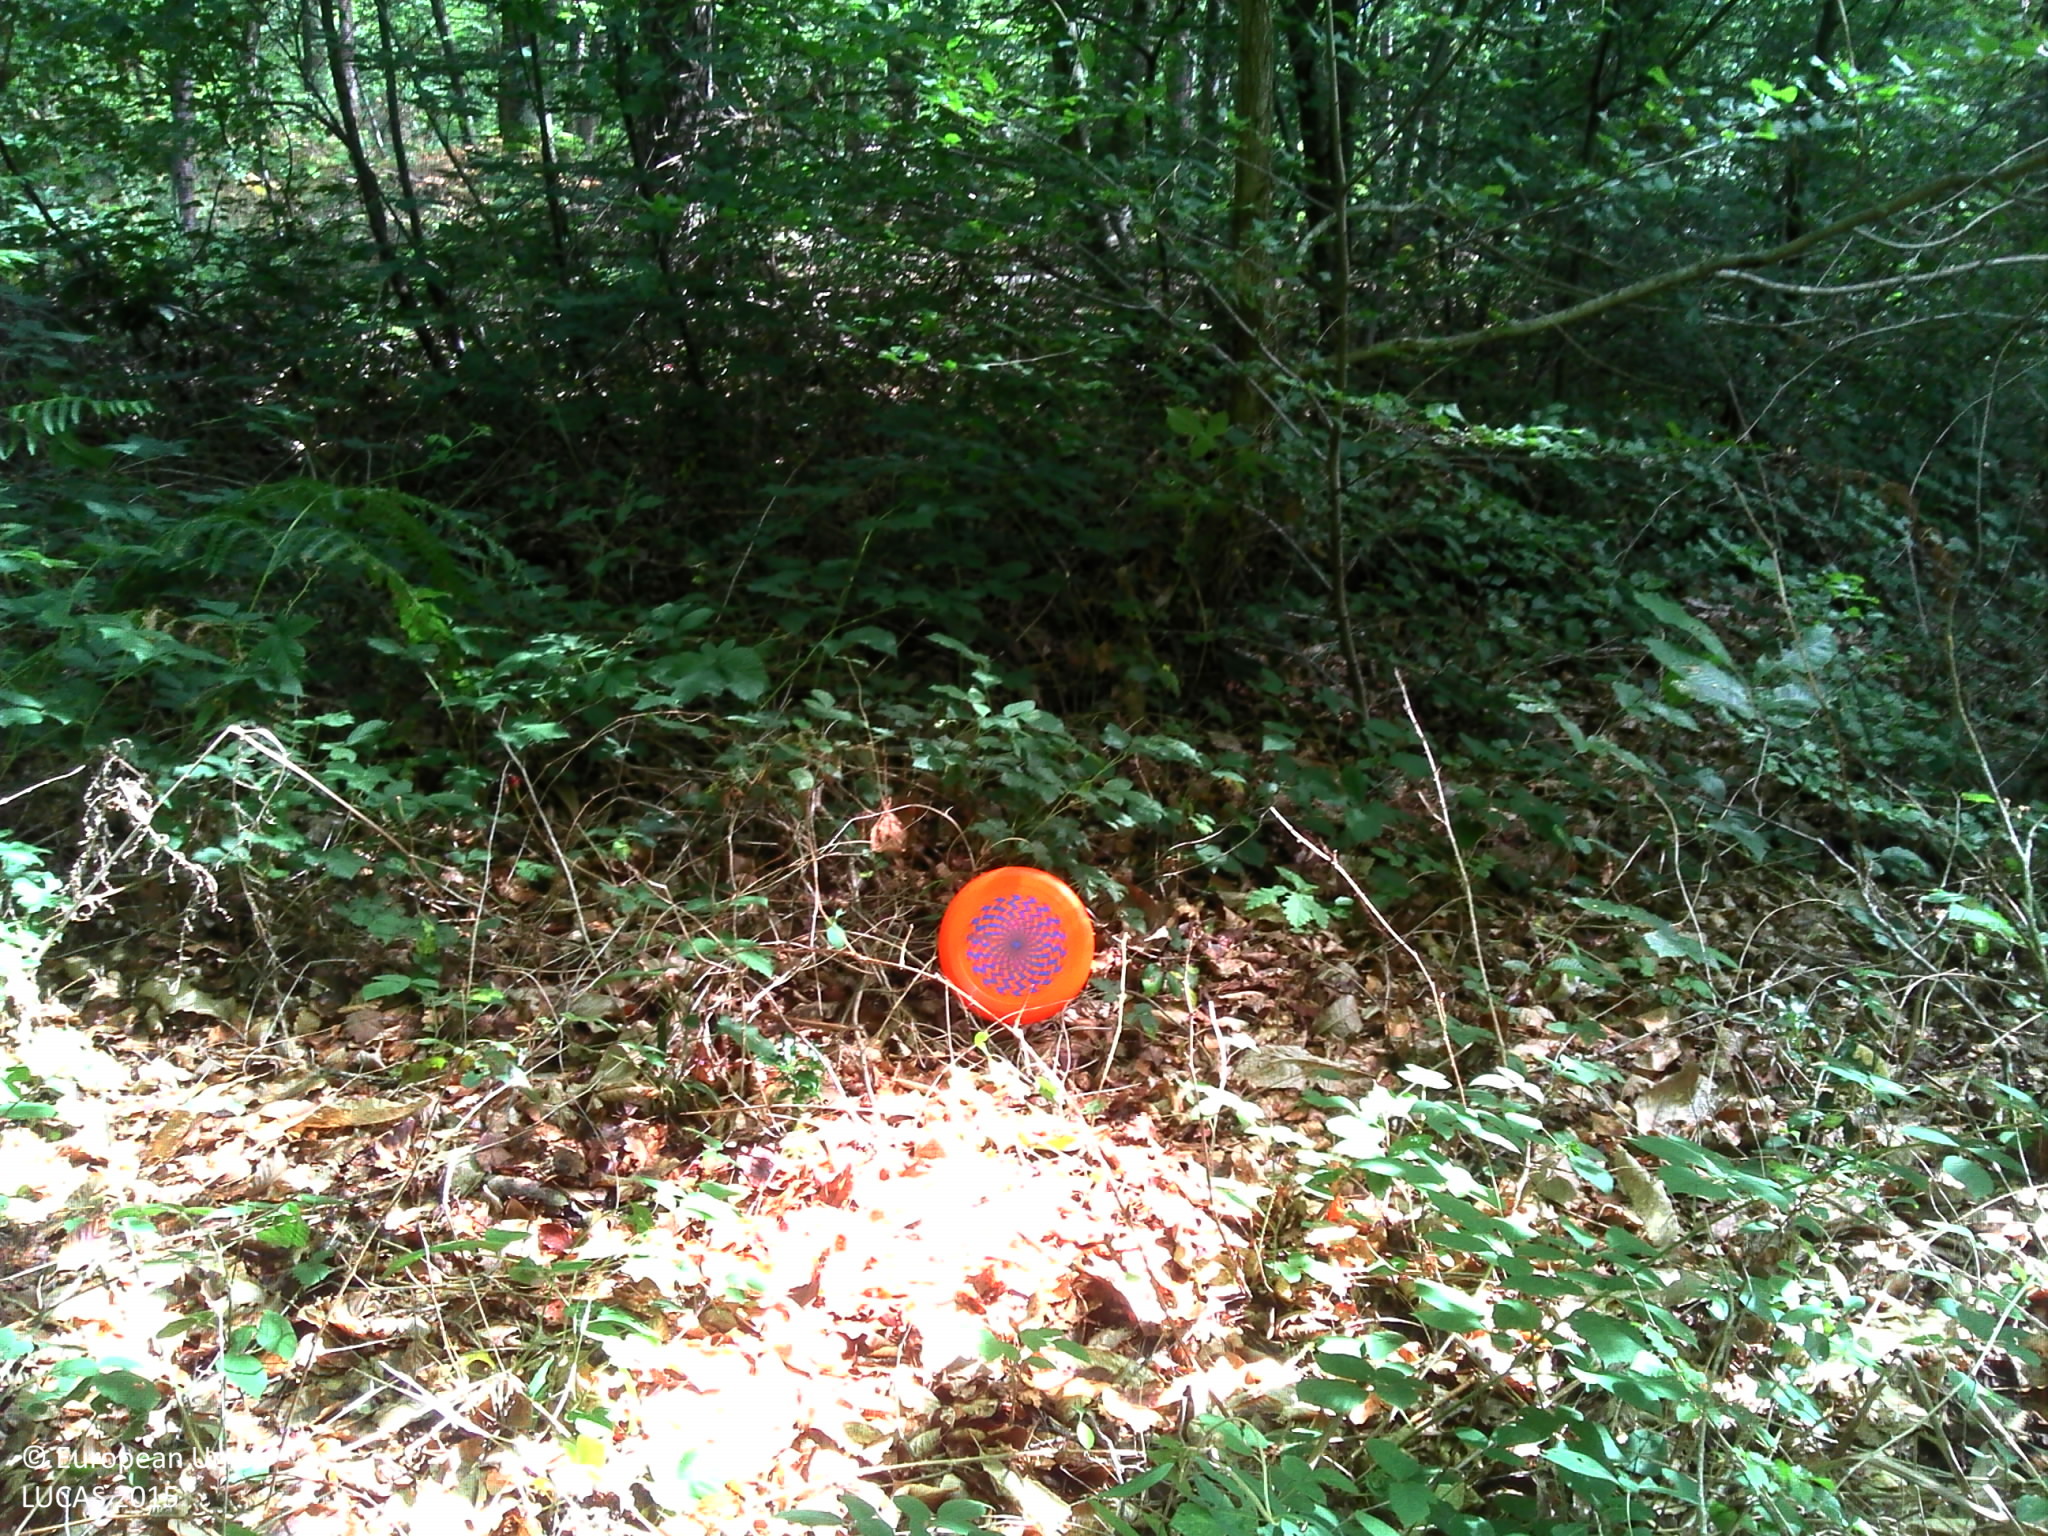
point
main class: Woodland
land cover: Broadleaved woodland
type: thermophilous deciduous forest
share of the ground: > 75 %
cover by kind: shrubs 40 %, broadleaved forest trees 30 %, unconsolidated bare surface 30 %
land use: Forestry
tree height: > 5 m
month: August
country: FR
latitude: 48.3994
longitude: 2.7375
